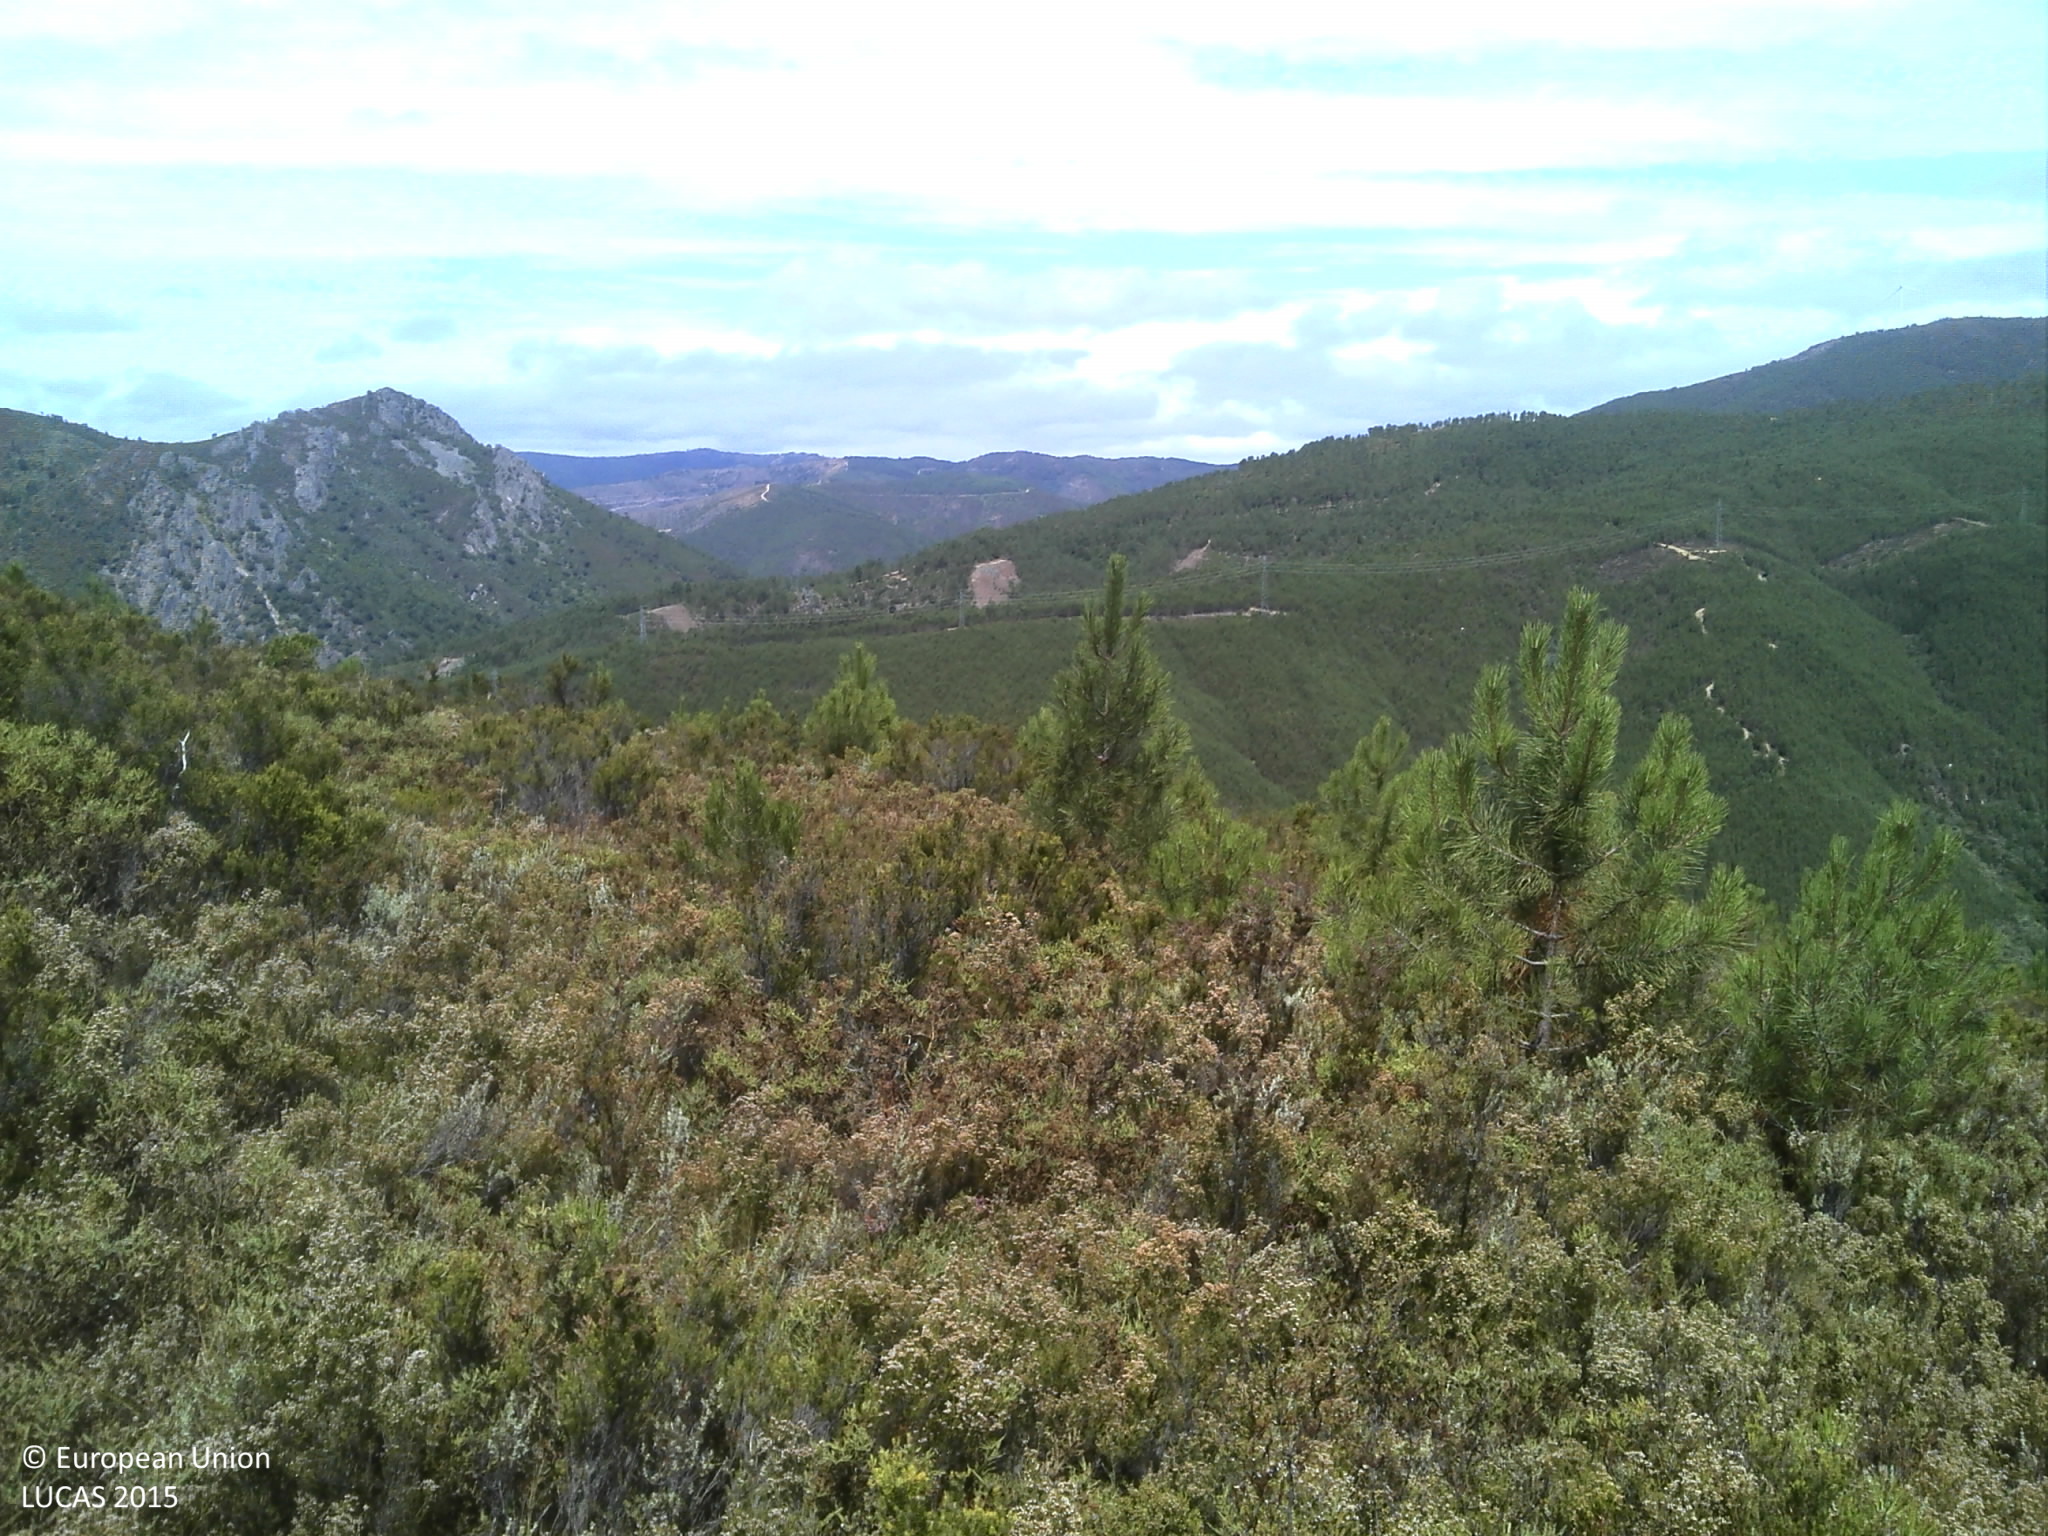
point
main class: Shrubland
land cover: Shrubland without tree cover
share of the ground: > 75 %
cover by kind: shrubs 90 %, unconsolidated bare surface 10 %
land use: Semi-natural and natural areas not in use
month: July
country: PT
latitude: 40.1575
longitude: -7.9018
